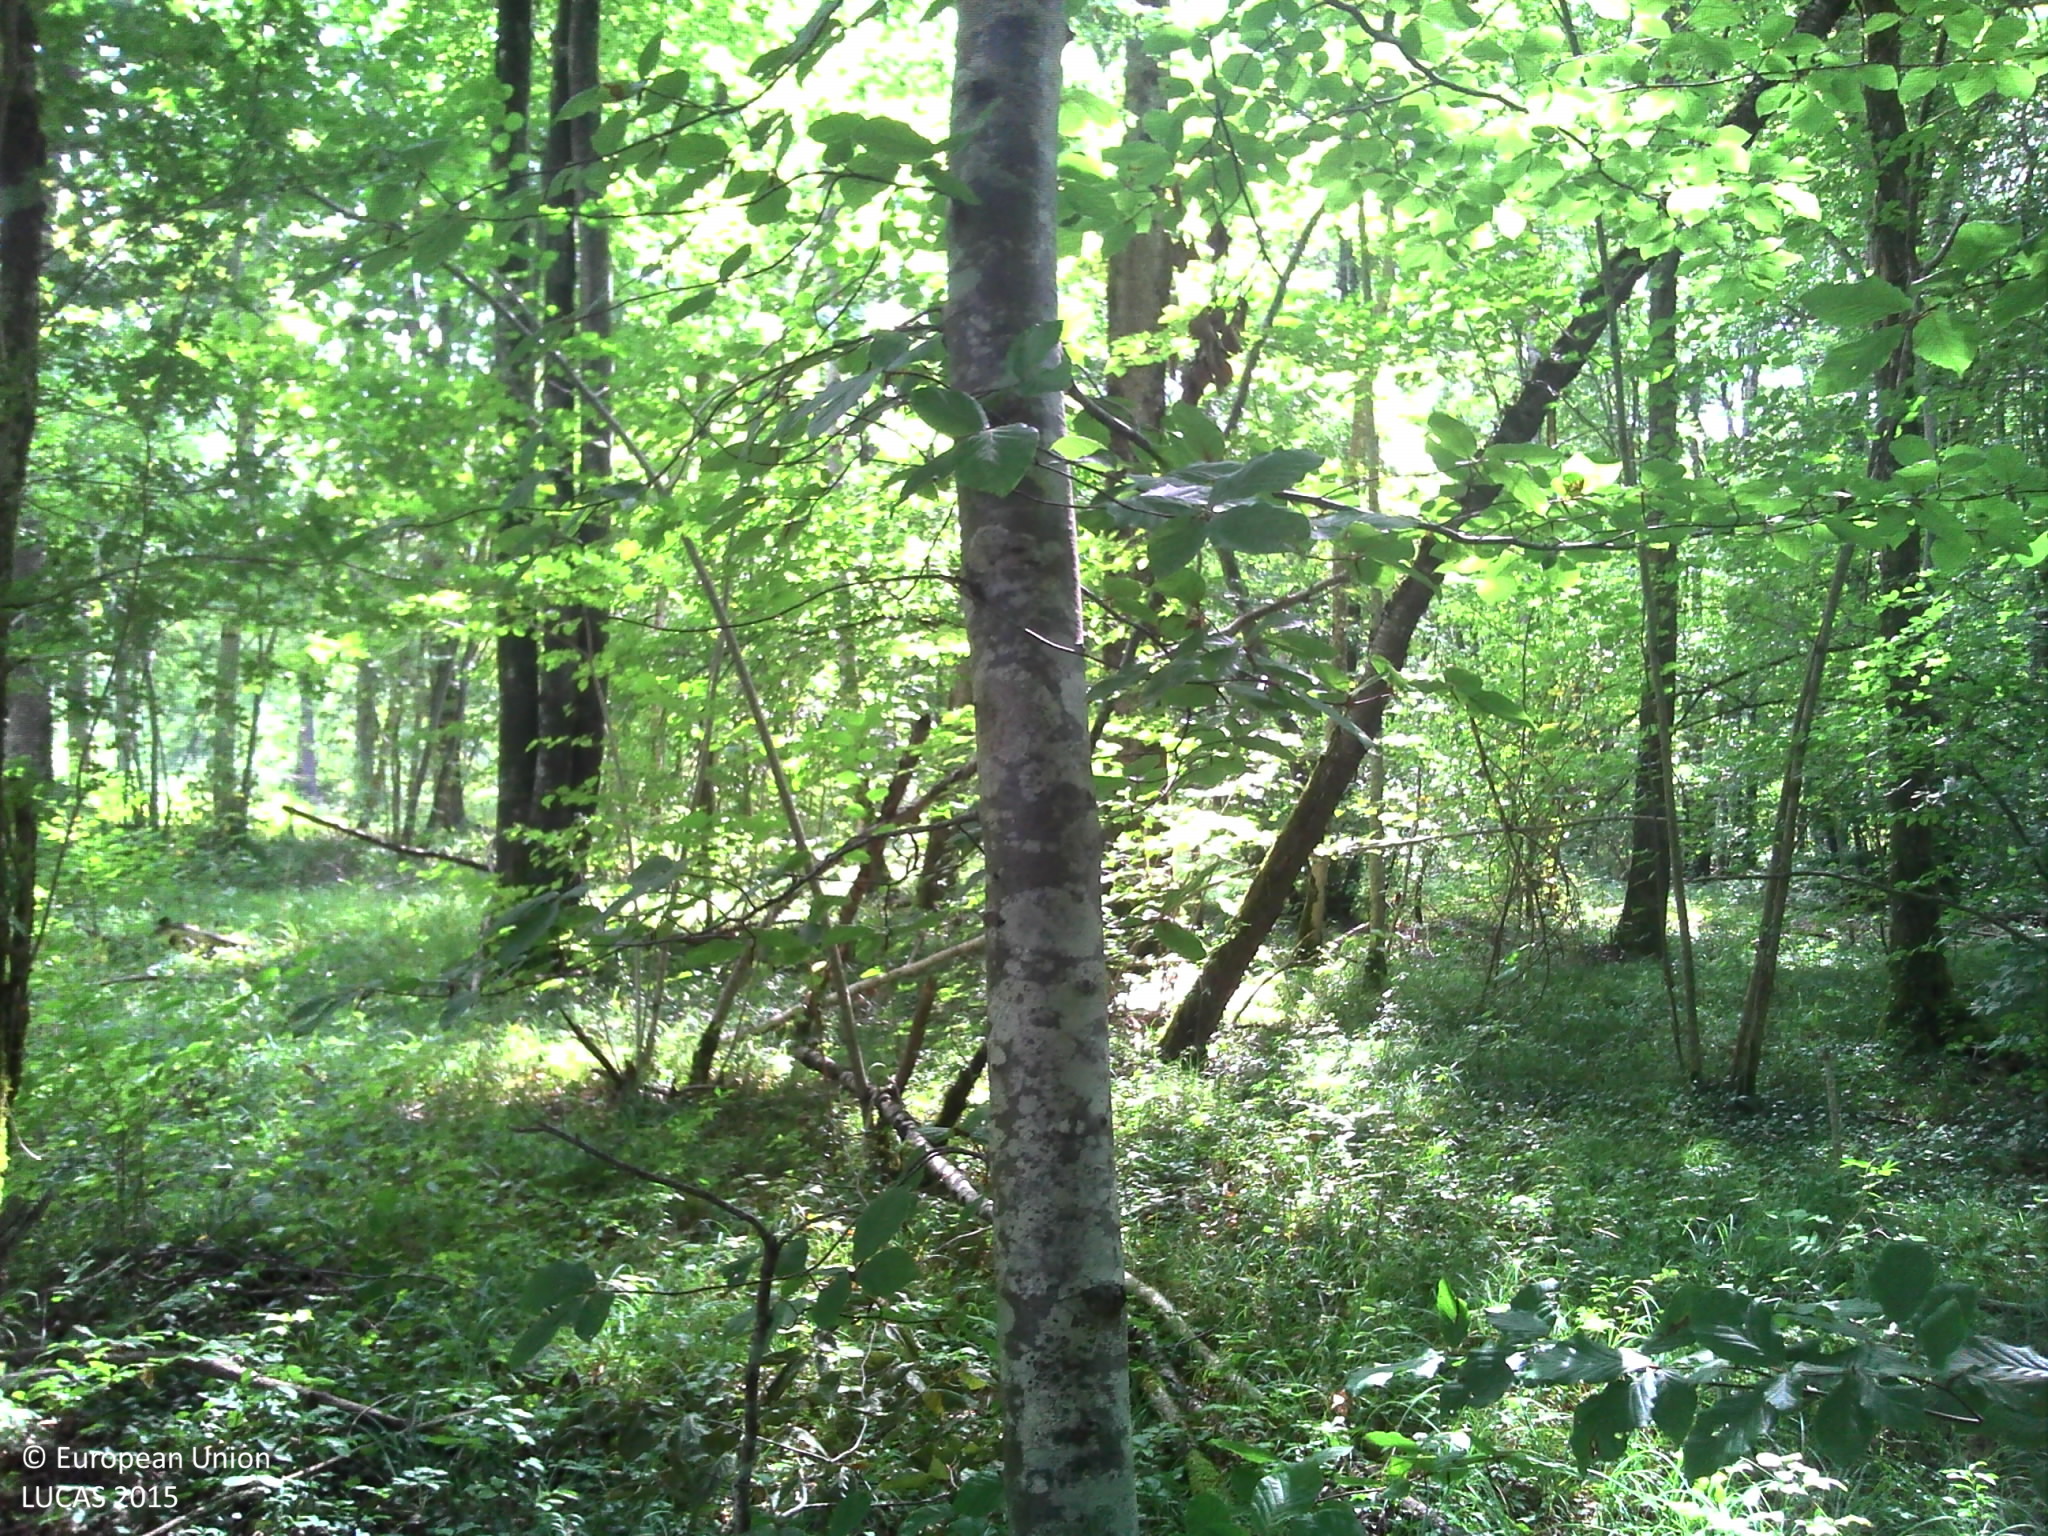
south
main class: Woodland
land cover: Broadleaved woodland
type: mesophytic deciduous forest
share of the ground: > 75 %
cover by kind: broadleaved forest trees 80 %, shrubs 10 %, herbaceous plants 10 %
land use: Forestry
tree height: > 5 m
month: September
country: FR
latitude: 47.4844
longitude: 4.7309
